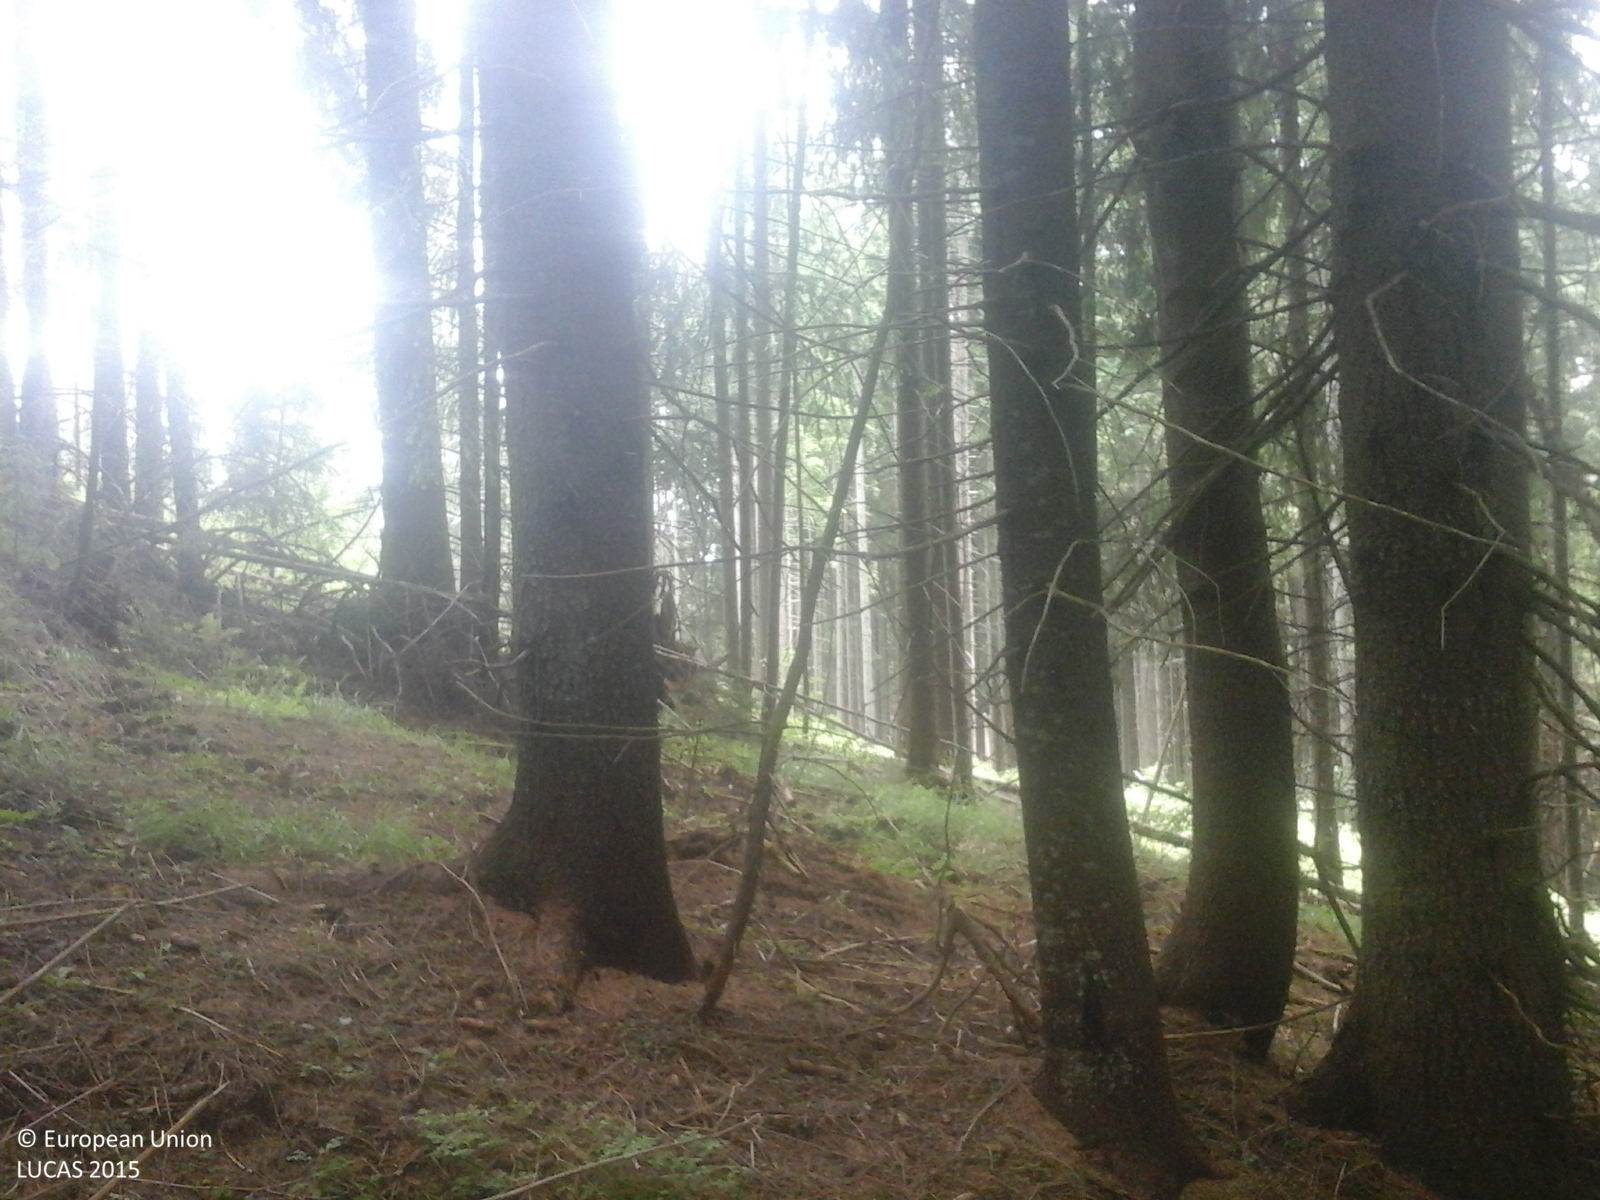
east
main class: Woodland
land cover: Spruce dominated coniferous woodland
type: alpine coniferous forest
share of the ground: > 75 %
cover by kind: coniferous forest trees 90 %, broadleaved forest trees 10 %
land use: Forestry
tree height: > 5 m
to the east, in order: Spruce dominated coniferous woodland; Other mixed woodland; Ditches and canals; Spruce dominated coniferous woodland
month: June
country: RO
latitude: 47.4281
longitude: 25.1272
